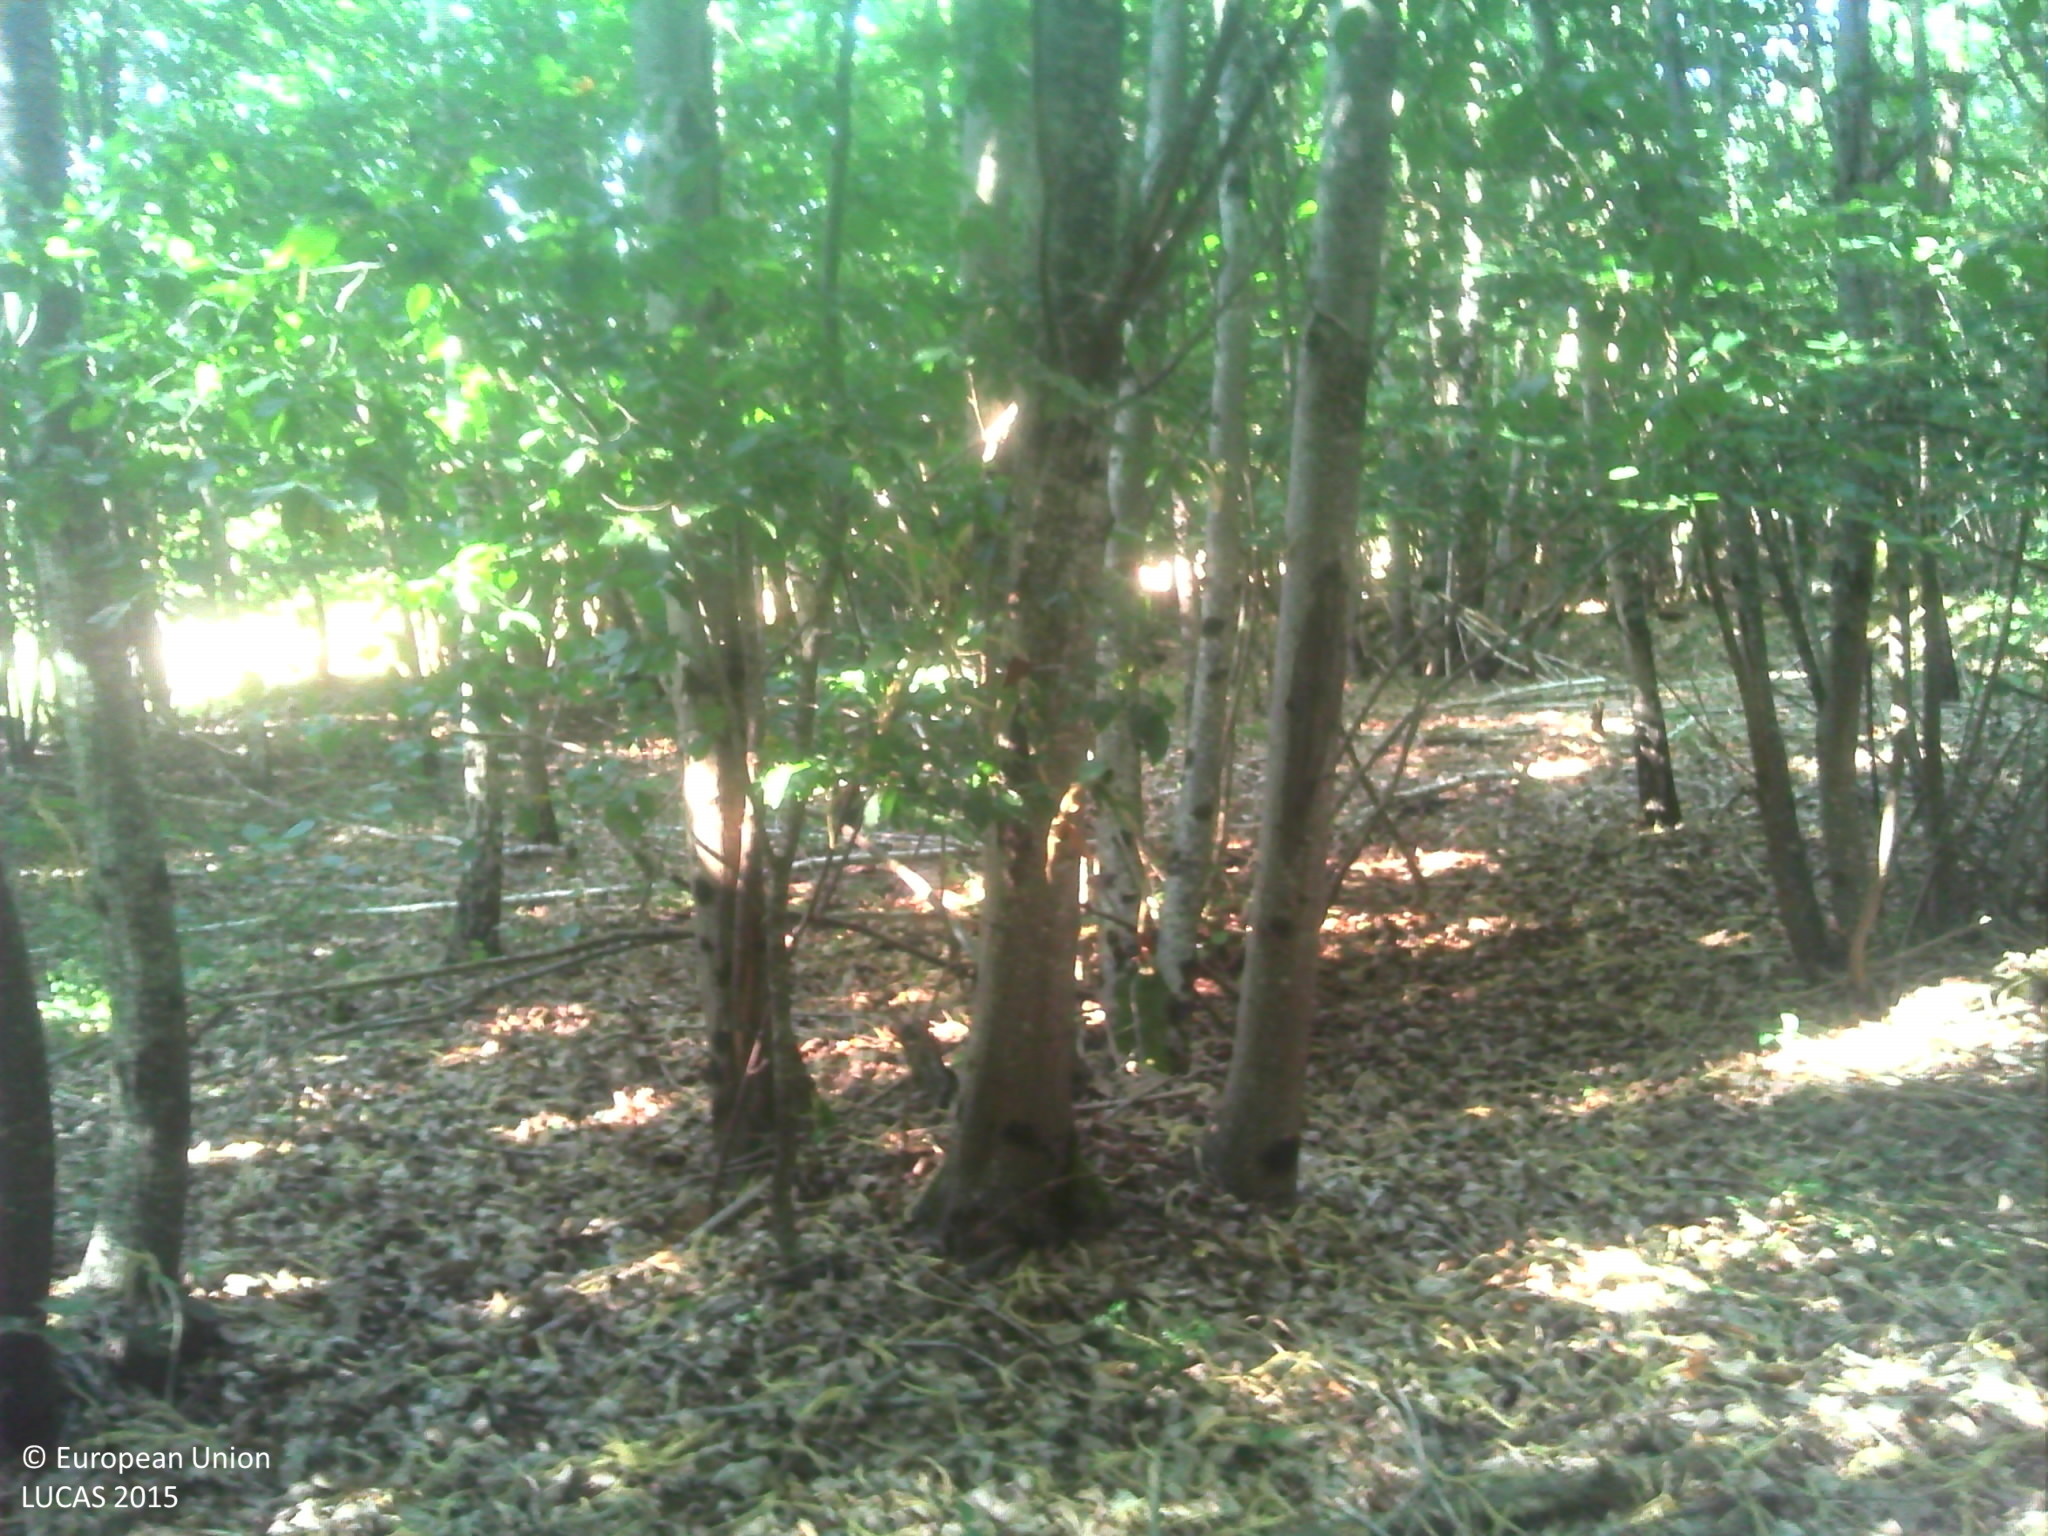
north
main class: Woodland
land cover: Broadleaved woodland
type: mesophytic deciduous forest
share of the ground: > 75 %
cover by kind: broadleaved forest trees 80 %, herbaceous plants 10 %, lichens and mosses 5 %, unconsolidated bare surface 5 %
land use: Forestry
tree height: > 5 m
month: July
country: FR
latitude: 47.7044
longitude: 0.7174
